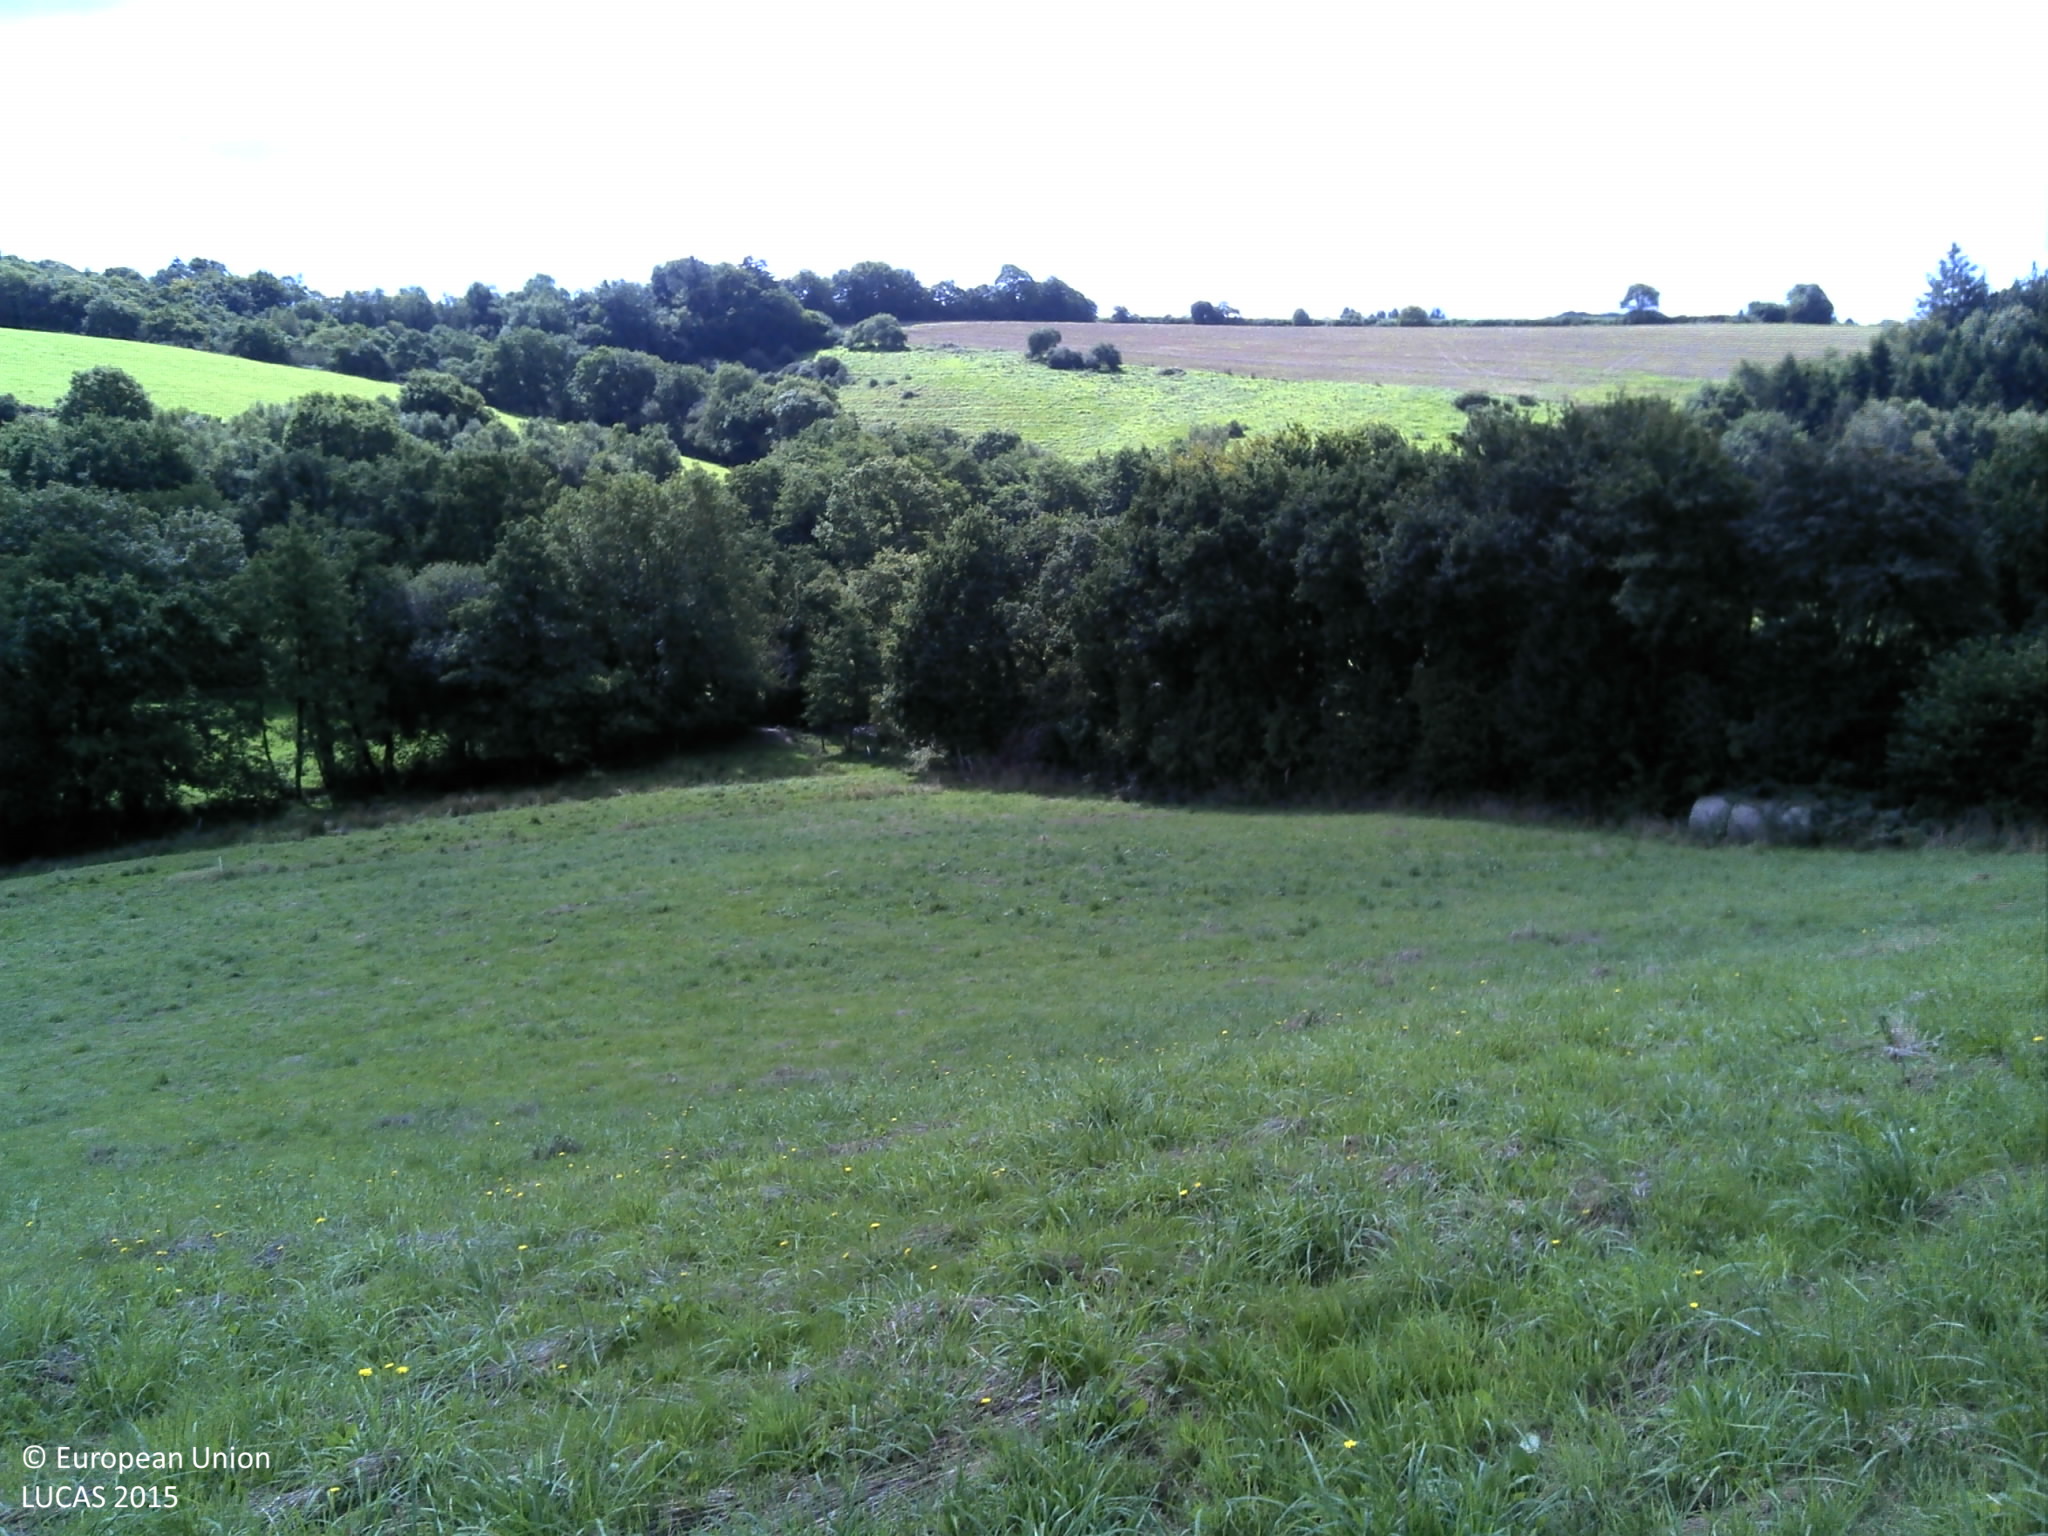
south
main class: Grassland
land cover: Grassland without tree/shrub cover
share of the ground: > 75 %
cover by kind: herbaceous plants 100 %
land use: Agriculture (excluding fallow land and kitchen gardens)
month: September
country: FR
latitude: 48.3972
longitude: -4.1790
